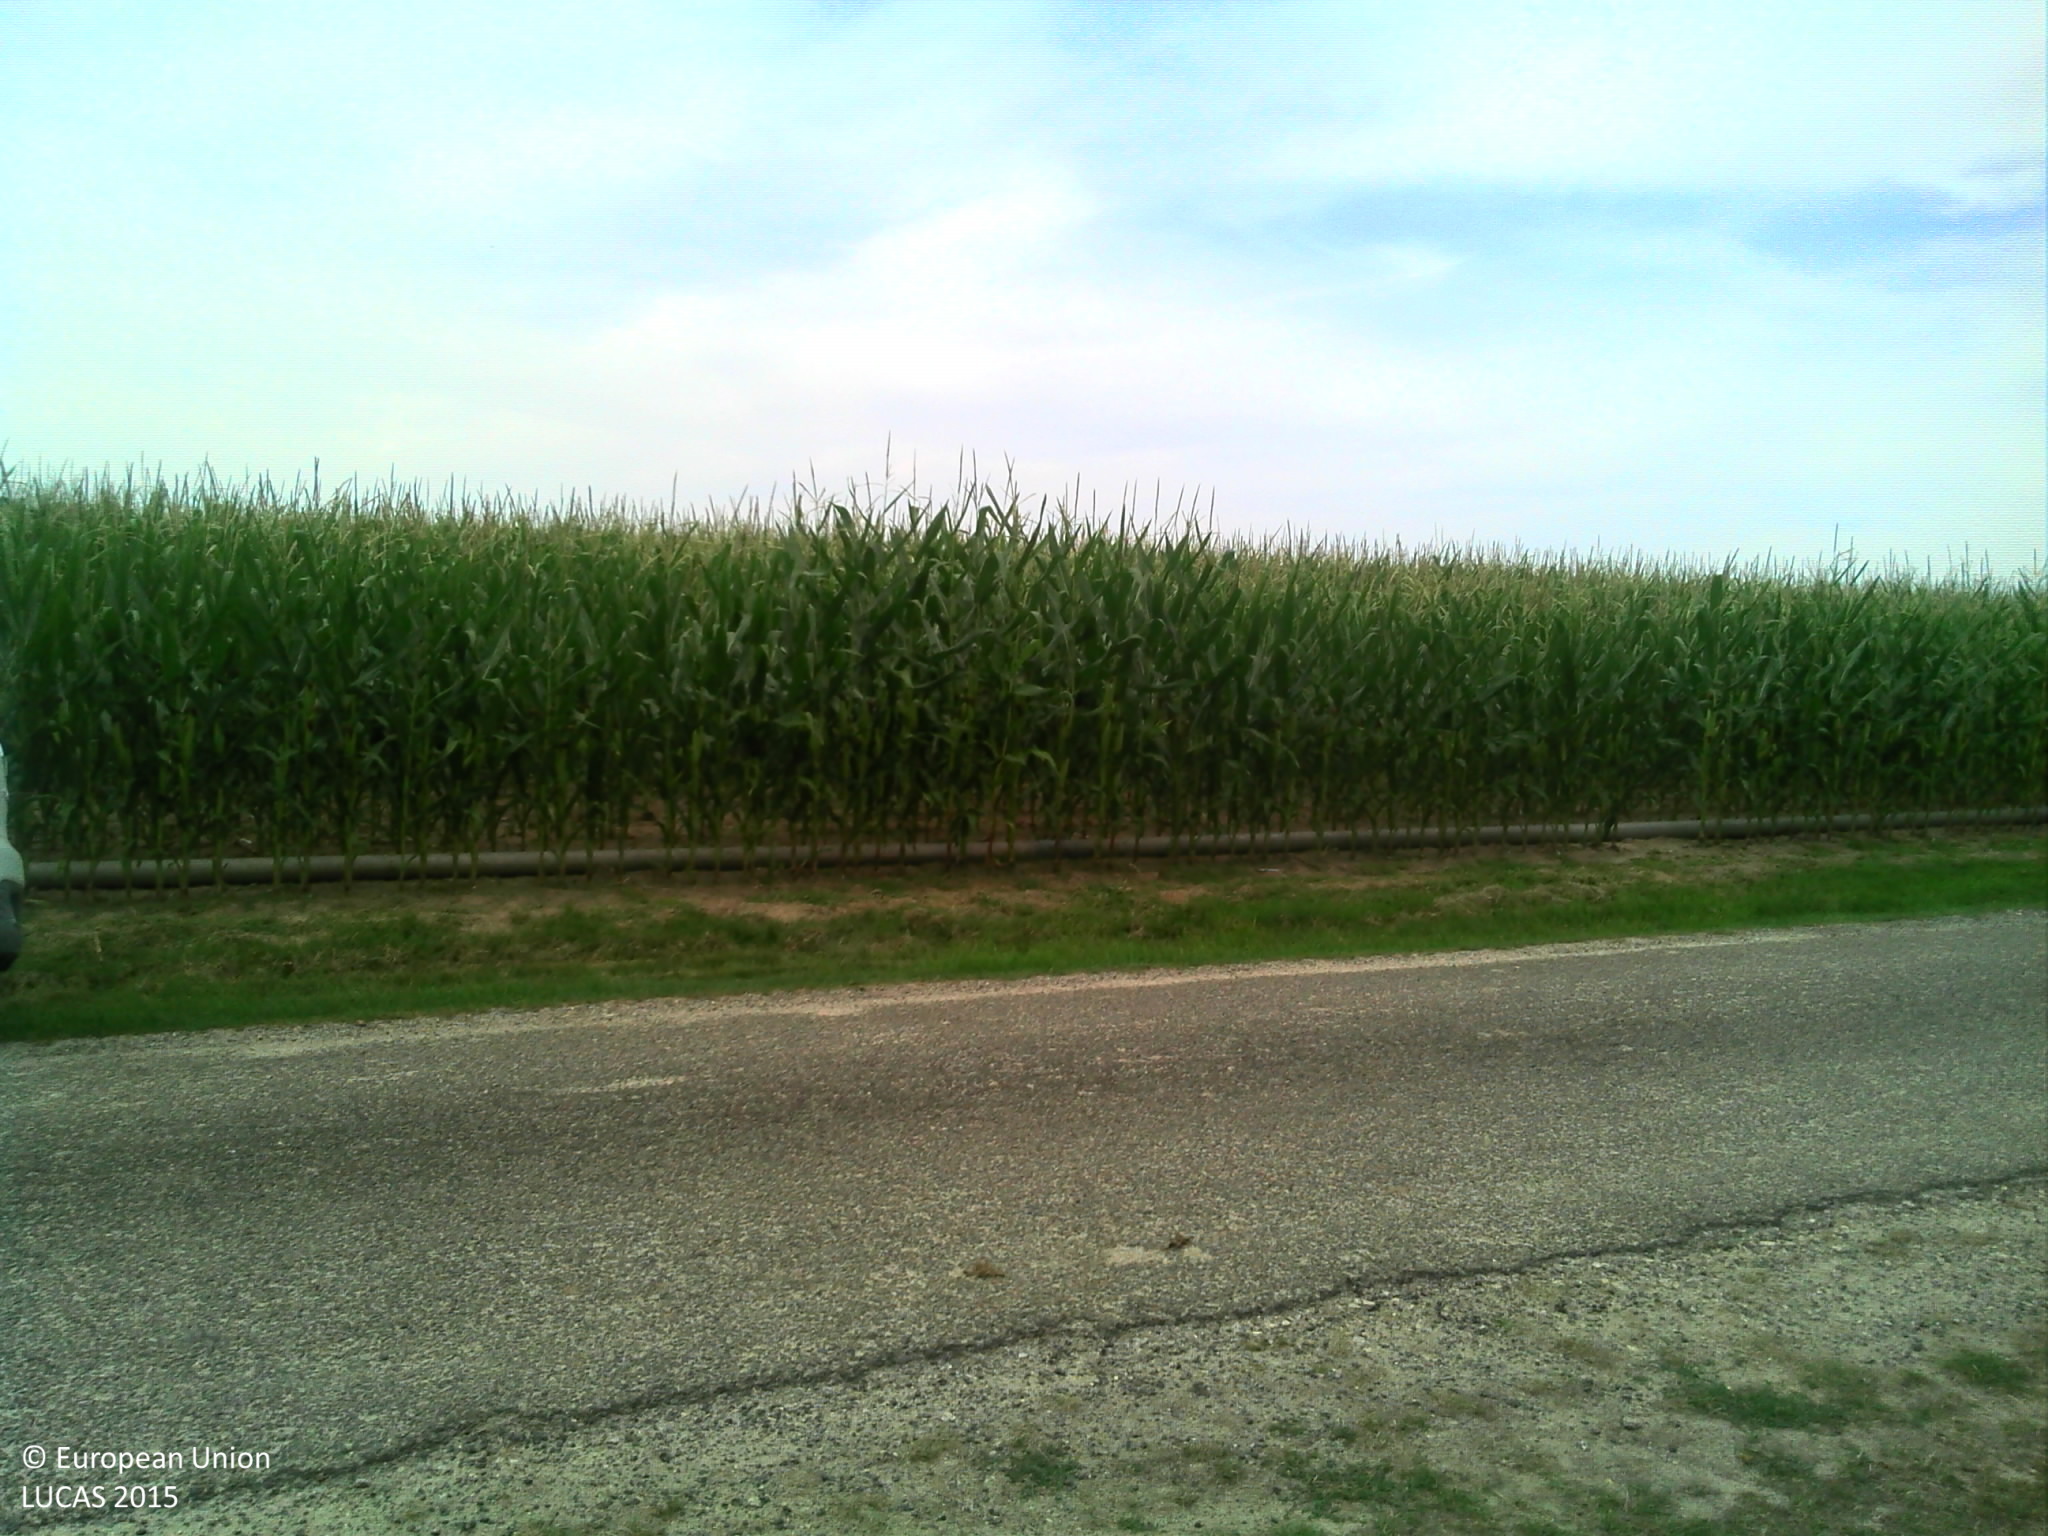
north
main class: Grassland
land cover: Grassland with sparse tree/shrub cover
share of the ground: > 75 %
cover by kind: herbaceous plants 95 %, broadleaved forest trees 5 %
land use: Residential
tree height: > 5 m
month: August
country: FR
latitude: 48.0434
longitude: 2.0334
